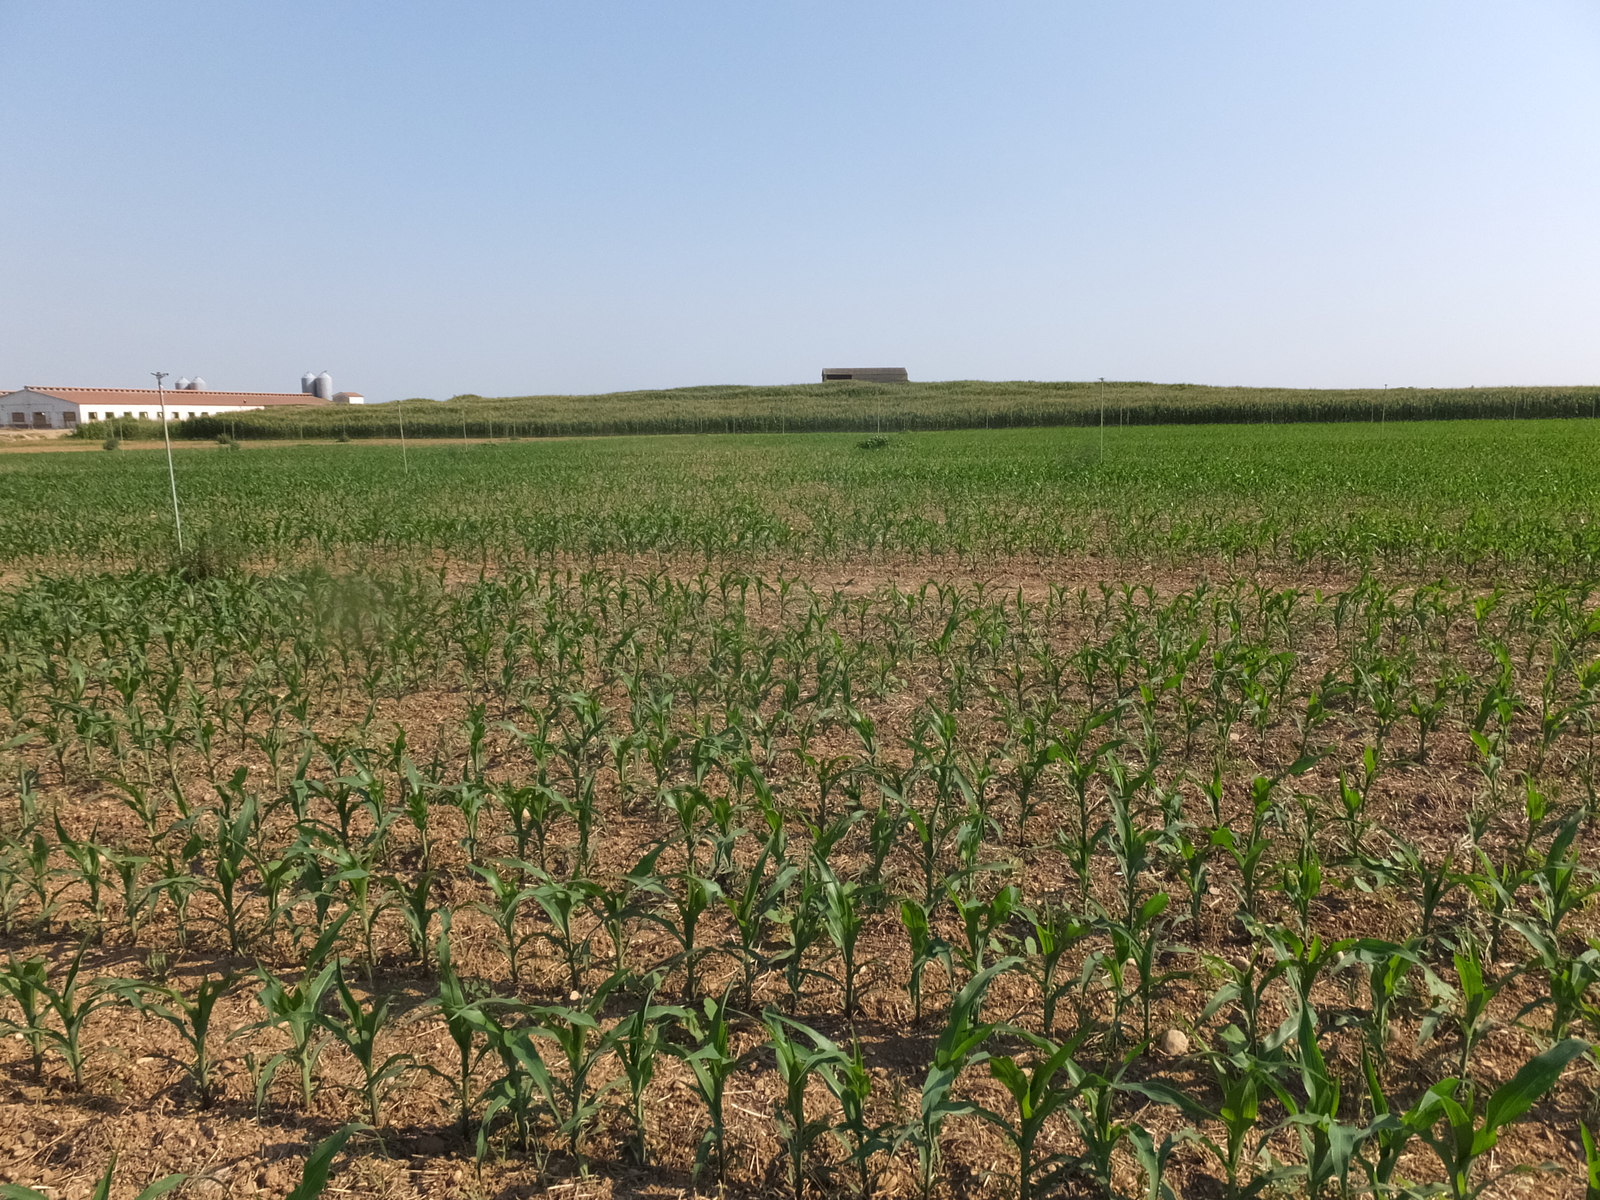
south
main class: Cropland
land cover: Maize
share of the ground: 10 - 25 %
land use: Agriculture (excluding fallow land and kitchen gardens)
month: July
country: ES
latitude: 41.7157
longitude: 0.3097
